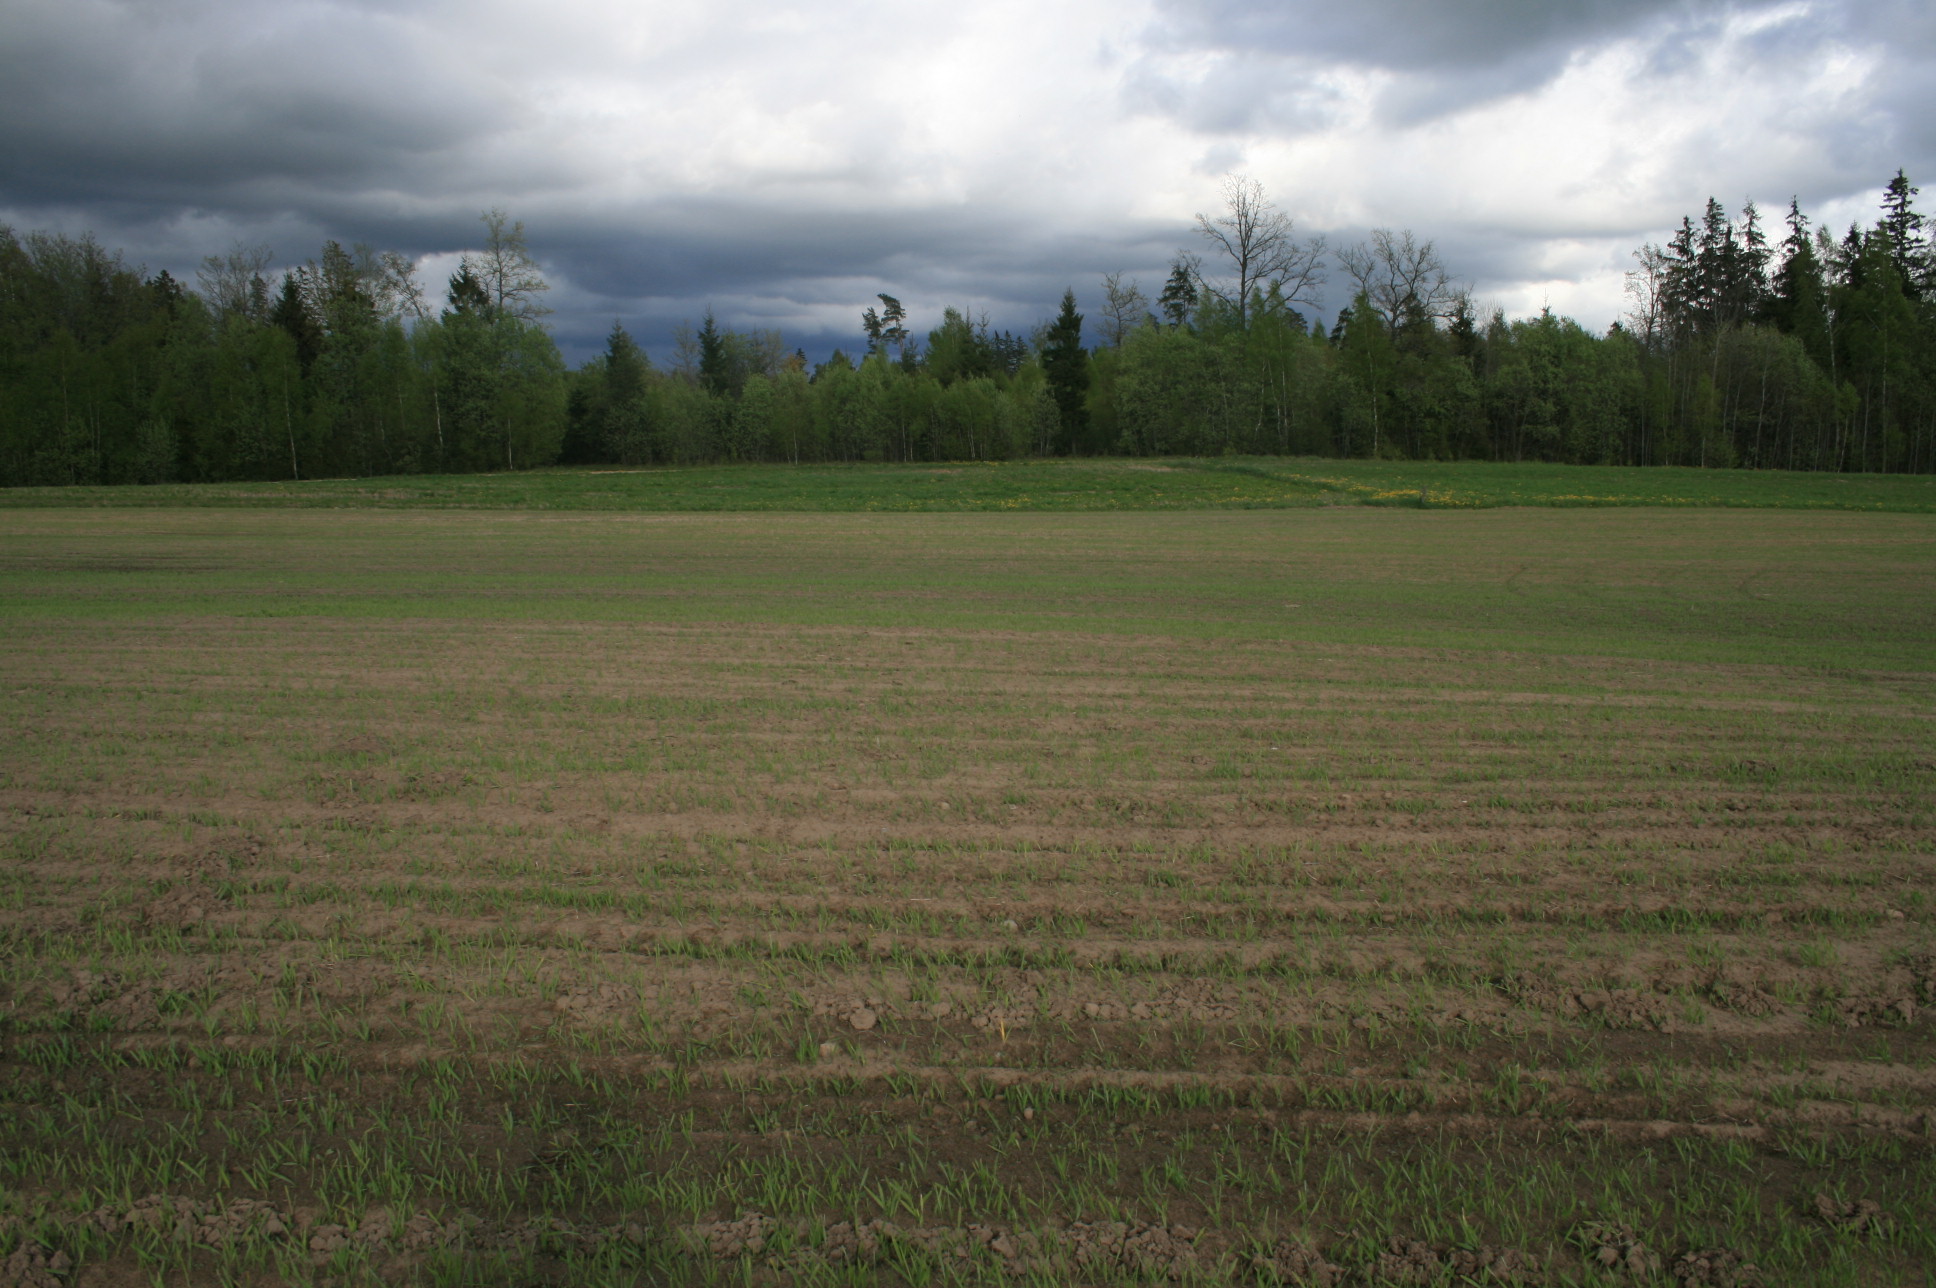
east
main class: Cropland
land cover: Barley
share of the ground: 10 - 25 %
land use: Agriculture (excluding fallow land and kitchen gardens)
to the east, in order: Barley; Grassland without tree/shrub cover; Tracks; Spruce dominated mixed woodland; Broadleaved woodland; Spruce dominated mixed woodland; Broadleaved woodland
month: May
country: LT
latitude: 56.1667
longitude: 22.0164
